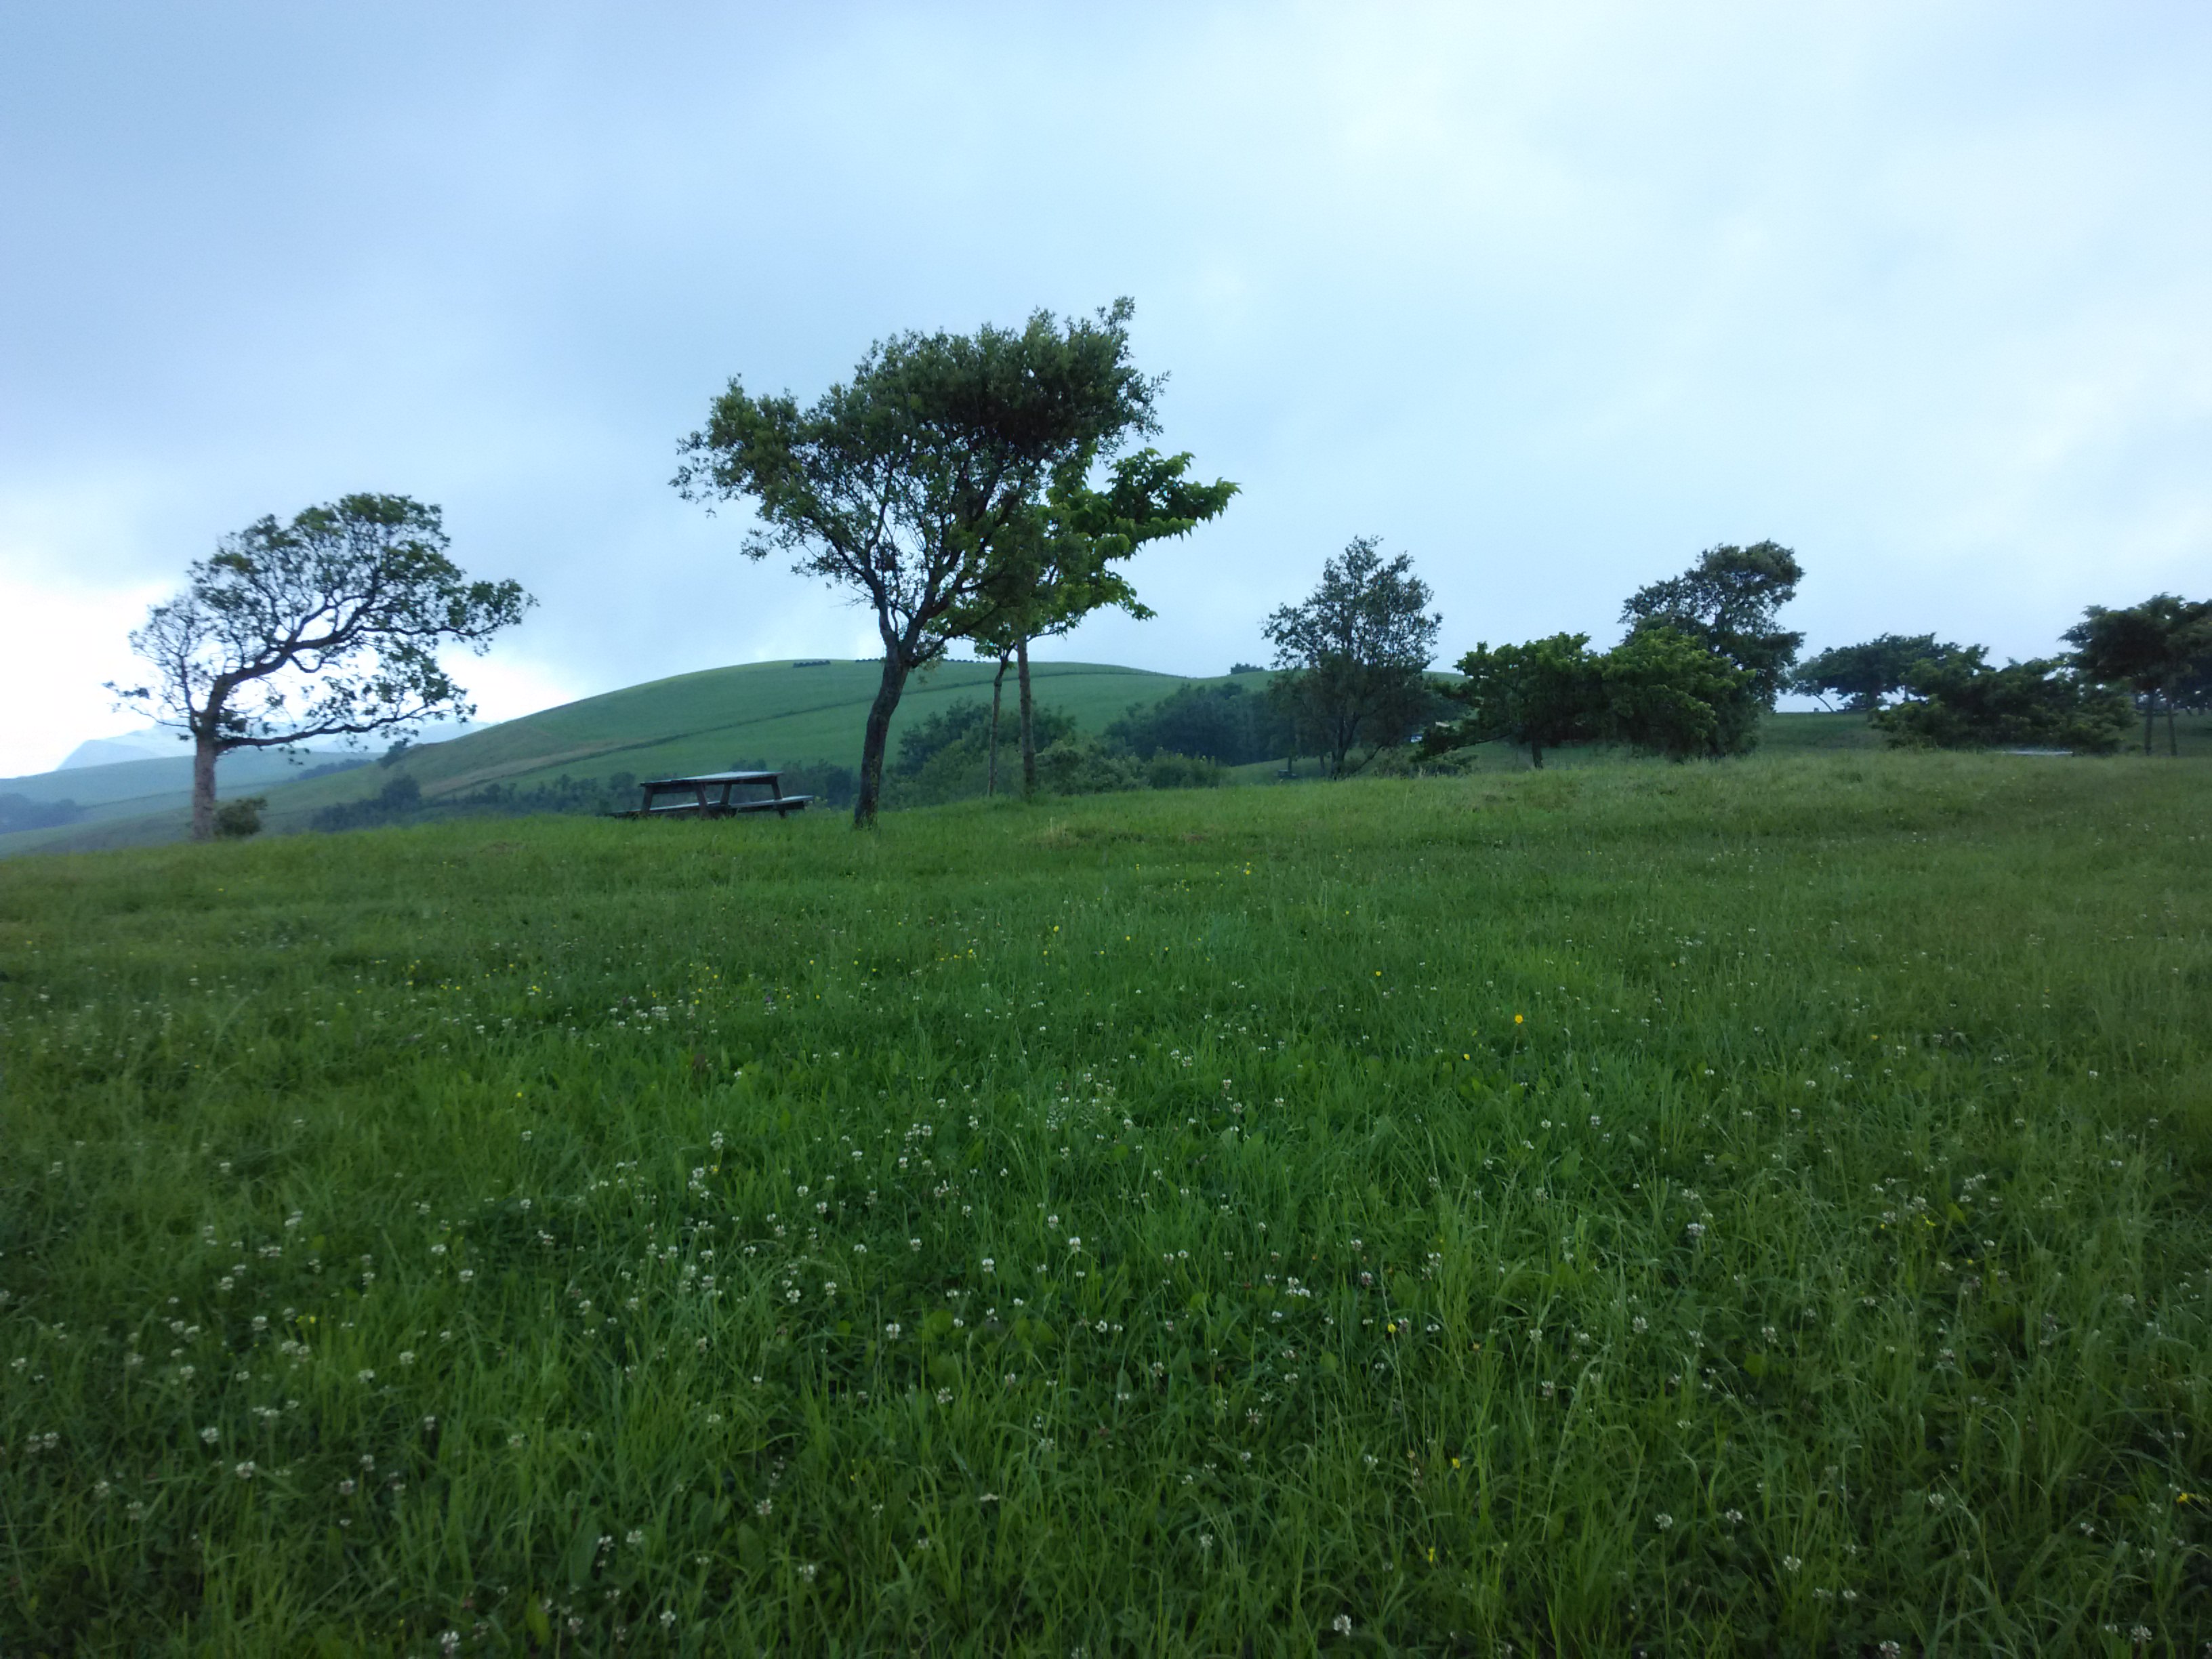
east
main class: Grassland
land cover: Grassland without tree/shrub cover
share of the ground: > 75 %
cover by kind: herbaceous plants 100 %
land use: Agriculture (excluding fallow land and kitchen gardens)
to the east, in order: Grassland without tree/shrub cover; Grassland with sparse tree/shrub cover; Broadleaved woodland; Grassland with sparse tree/shrub cover; Tracks; Grassland with sparse tree/shrub cover; Broadleaved woodland
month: June
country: ES
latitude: 43.2889
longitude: -2.2889
